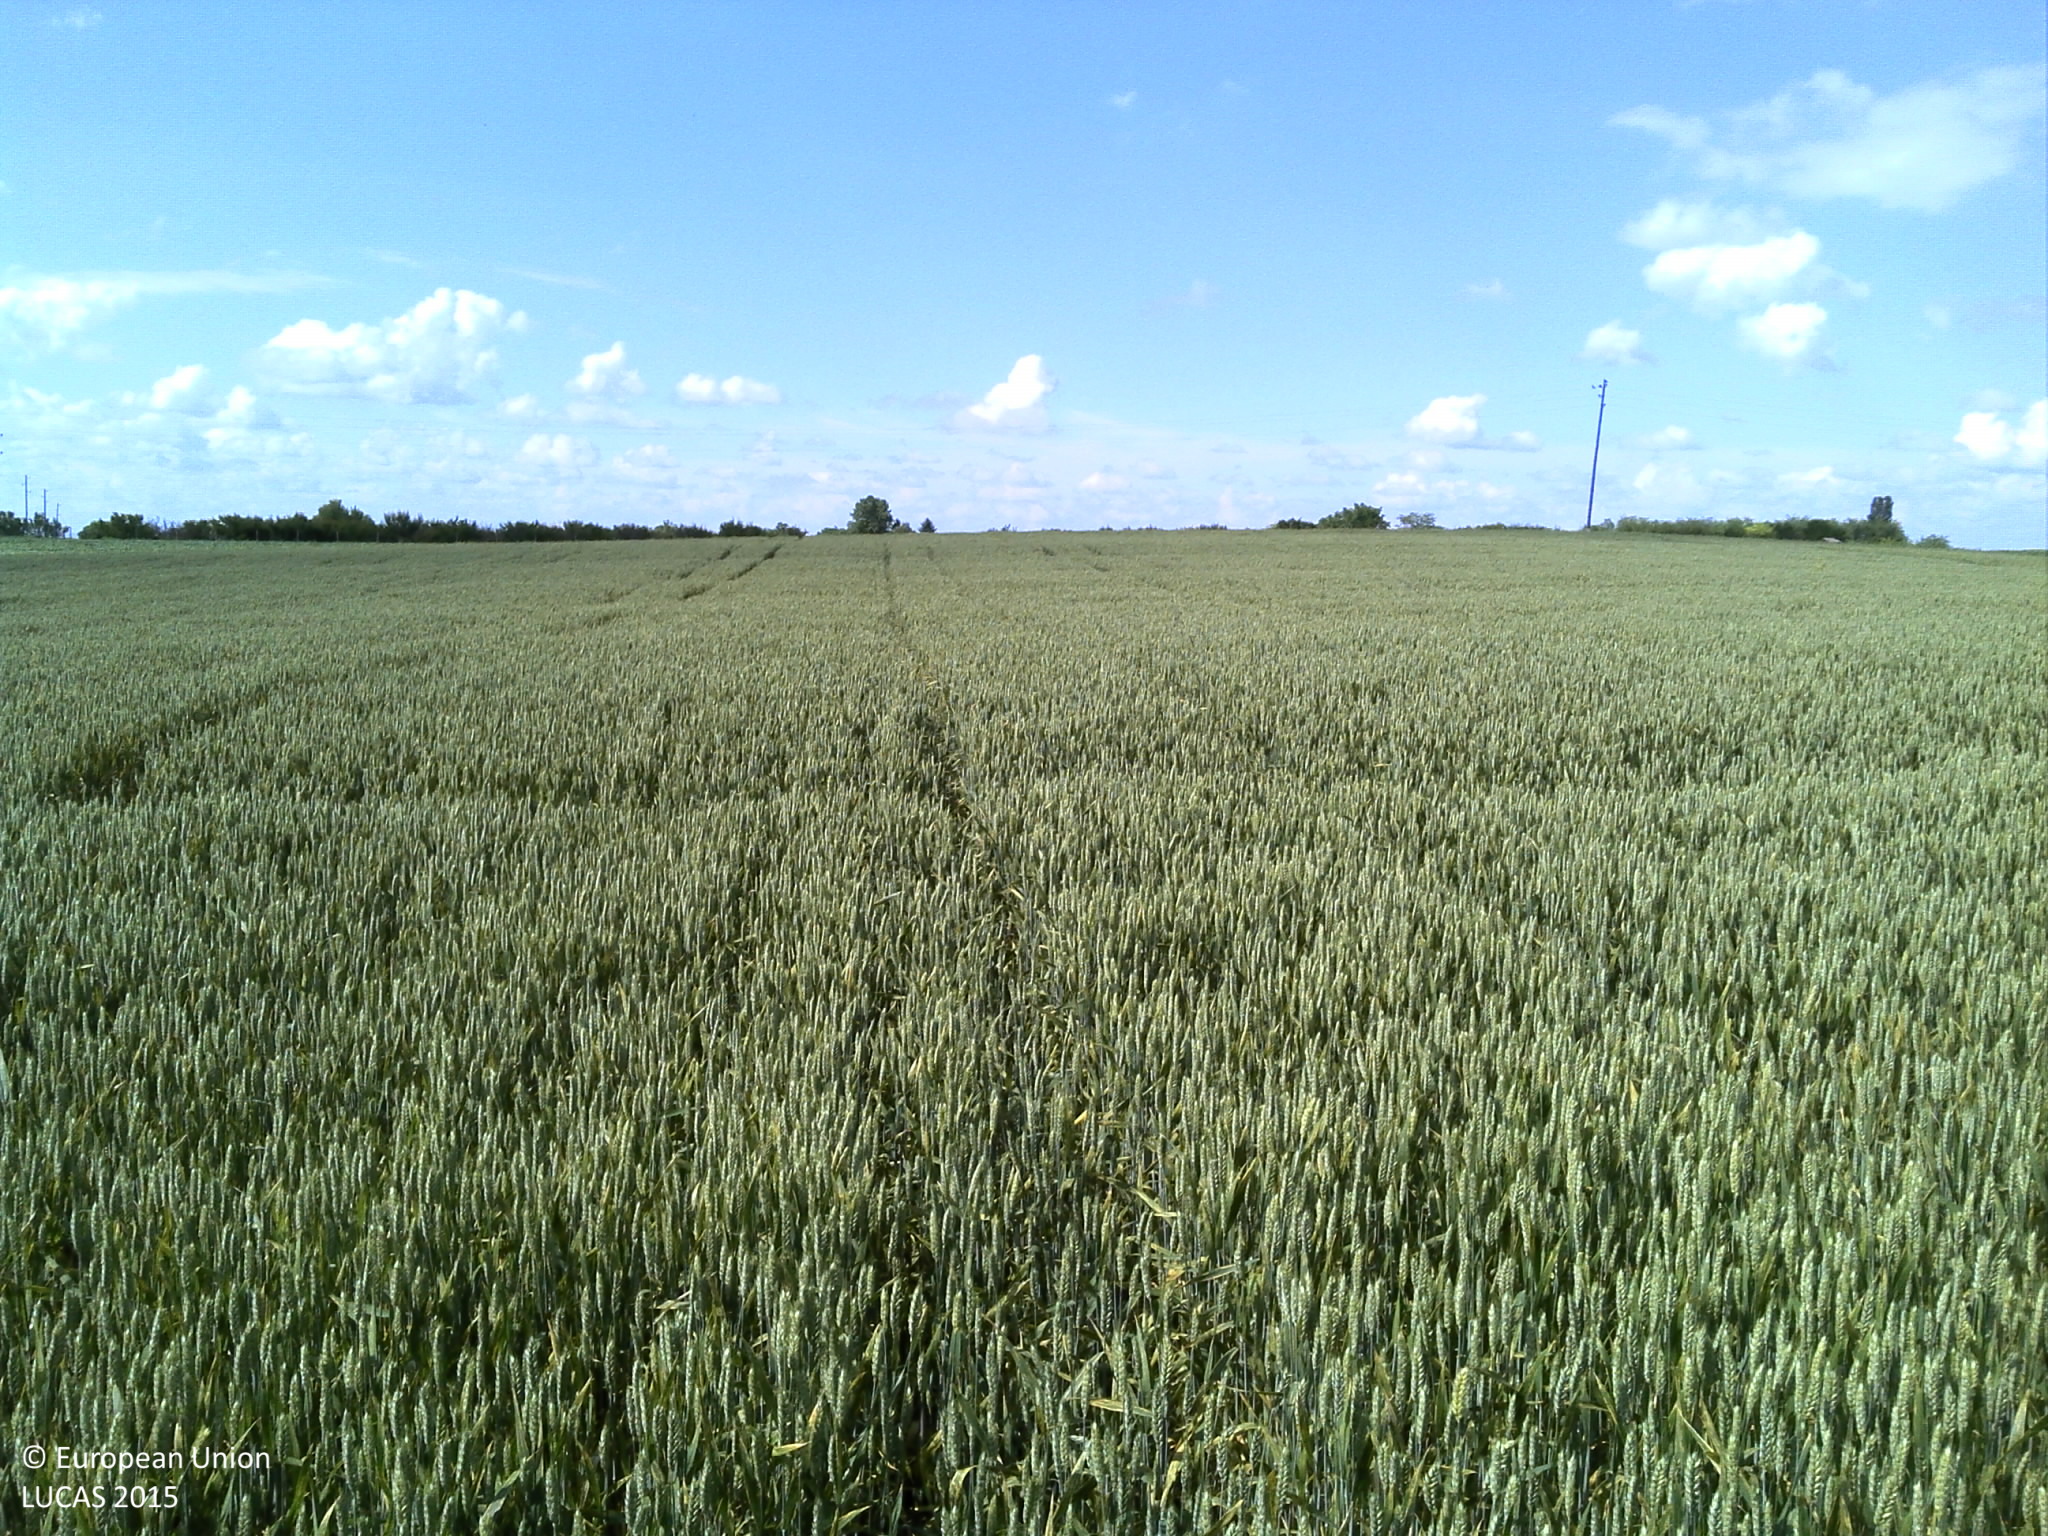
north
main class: Cropland
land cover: Common wheat
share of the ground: > 75 %
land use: Agriculture (excluding fallow land and kitchen gardens)
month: May
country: HR
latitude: 45.5217
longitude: 18.9583
